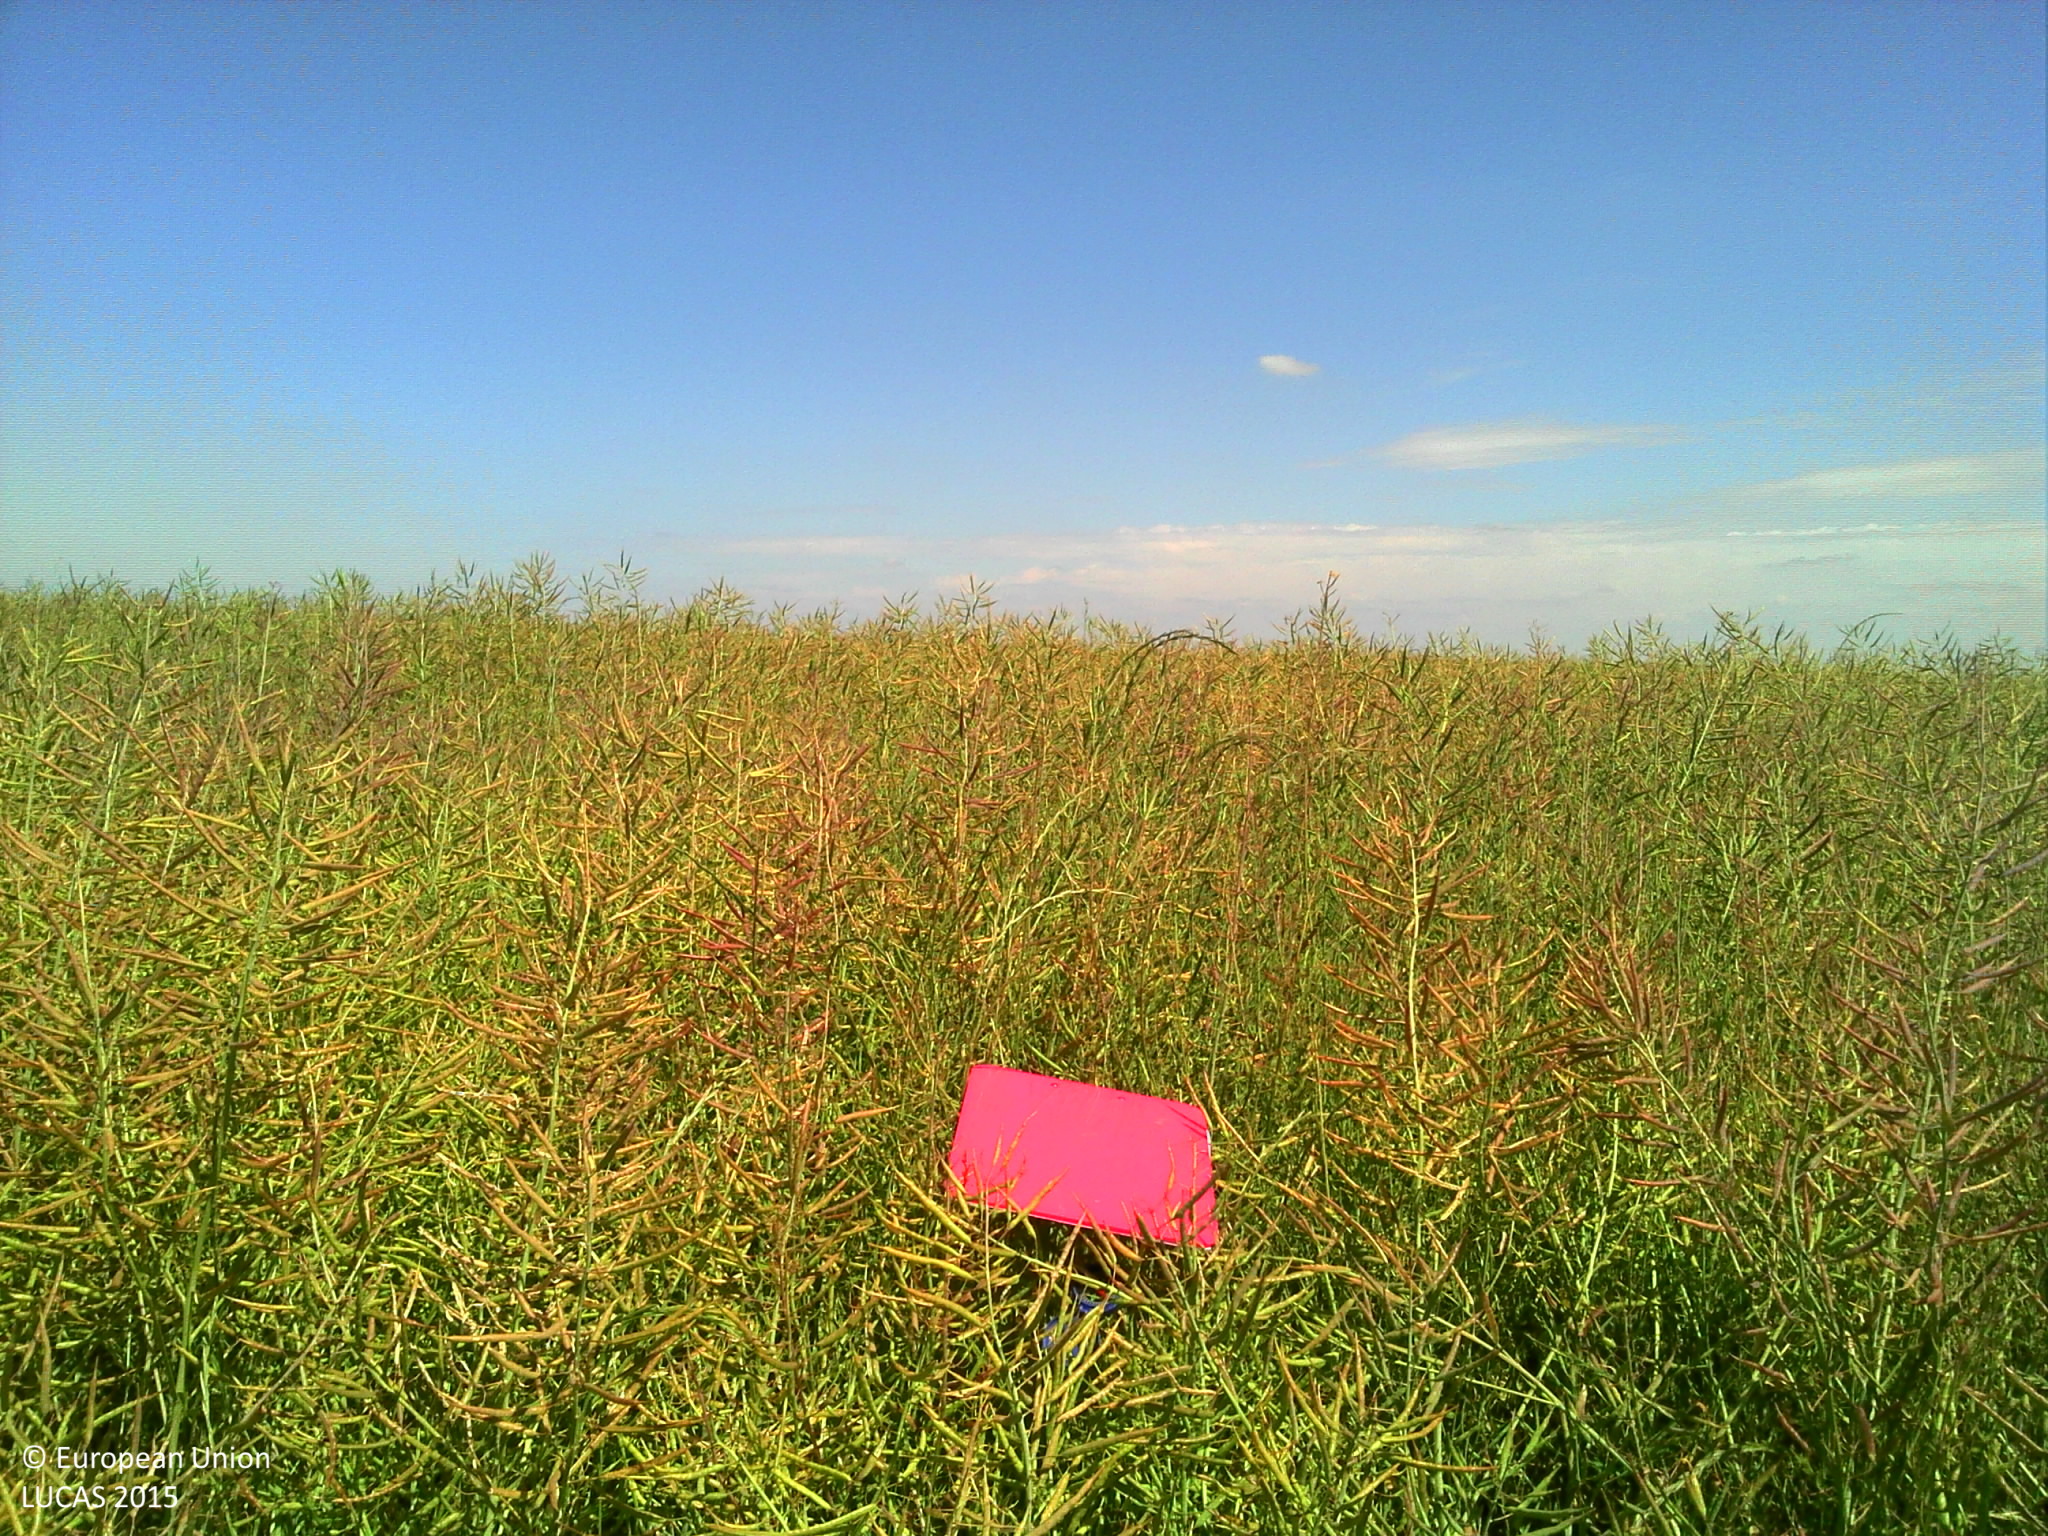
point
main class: Cropland
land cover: Rape and turnip rape
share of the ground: > 75 %
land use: Agriculture (excluding fallow land and kitchen gardens)
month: June
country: FR
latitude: 49.5065
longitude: 2.5447
